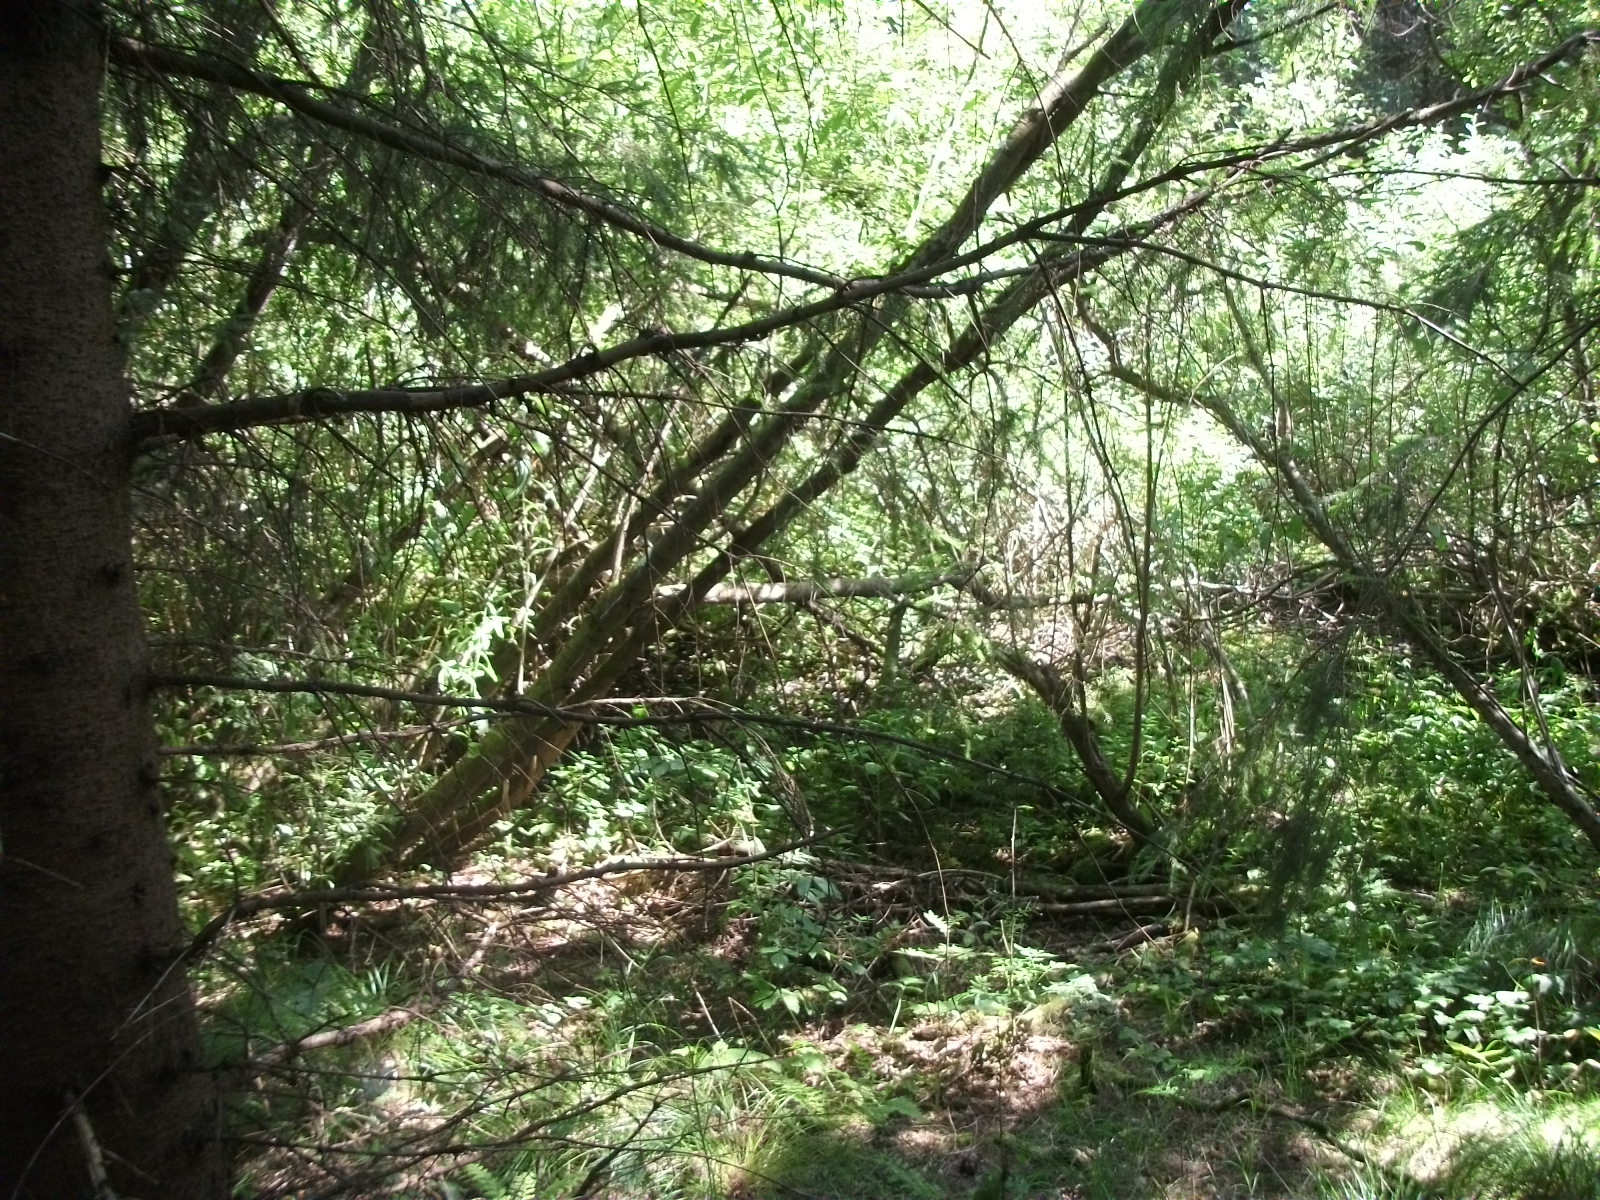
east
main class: Woodland
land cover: Spruce dominated coniferous woodland
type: hemiboreal forest and nemoral coniferous forest and mixed broadleaved-coniferous forest
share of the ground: > 75 %
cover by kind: coniferous forest trees 85 %, herbaceous plants 5 %, lichens and mosses 5 %, unconsolidated bare surface 5 %
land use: Forestry
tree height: > 5 m
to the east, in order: Spruce dominated coniferous woodland; Broadleaved woodland; Ponds and wetlands; Broadleaved woodland; Spruce dominated coniferous woodland; Rivers and streams; Broadleaved woodland
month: August
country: LV
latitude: 56.8799
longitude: 25.7301
